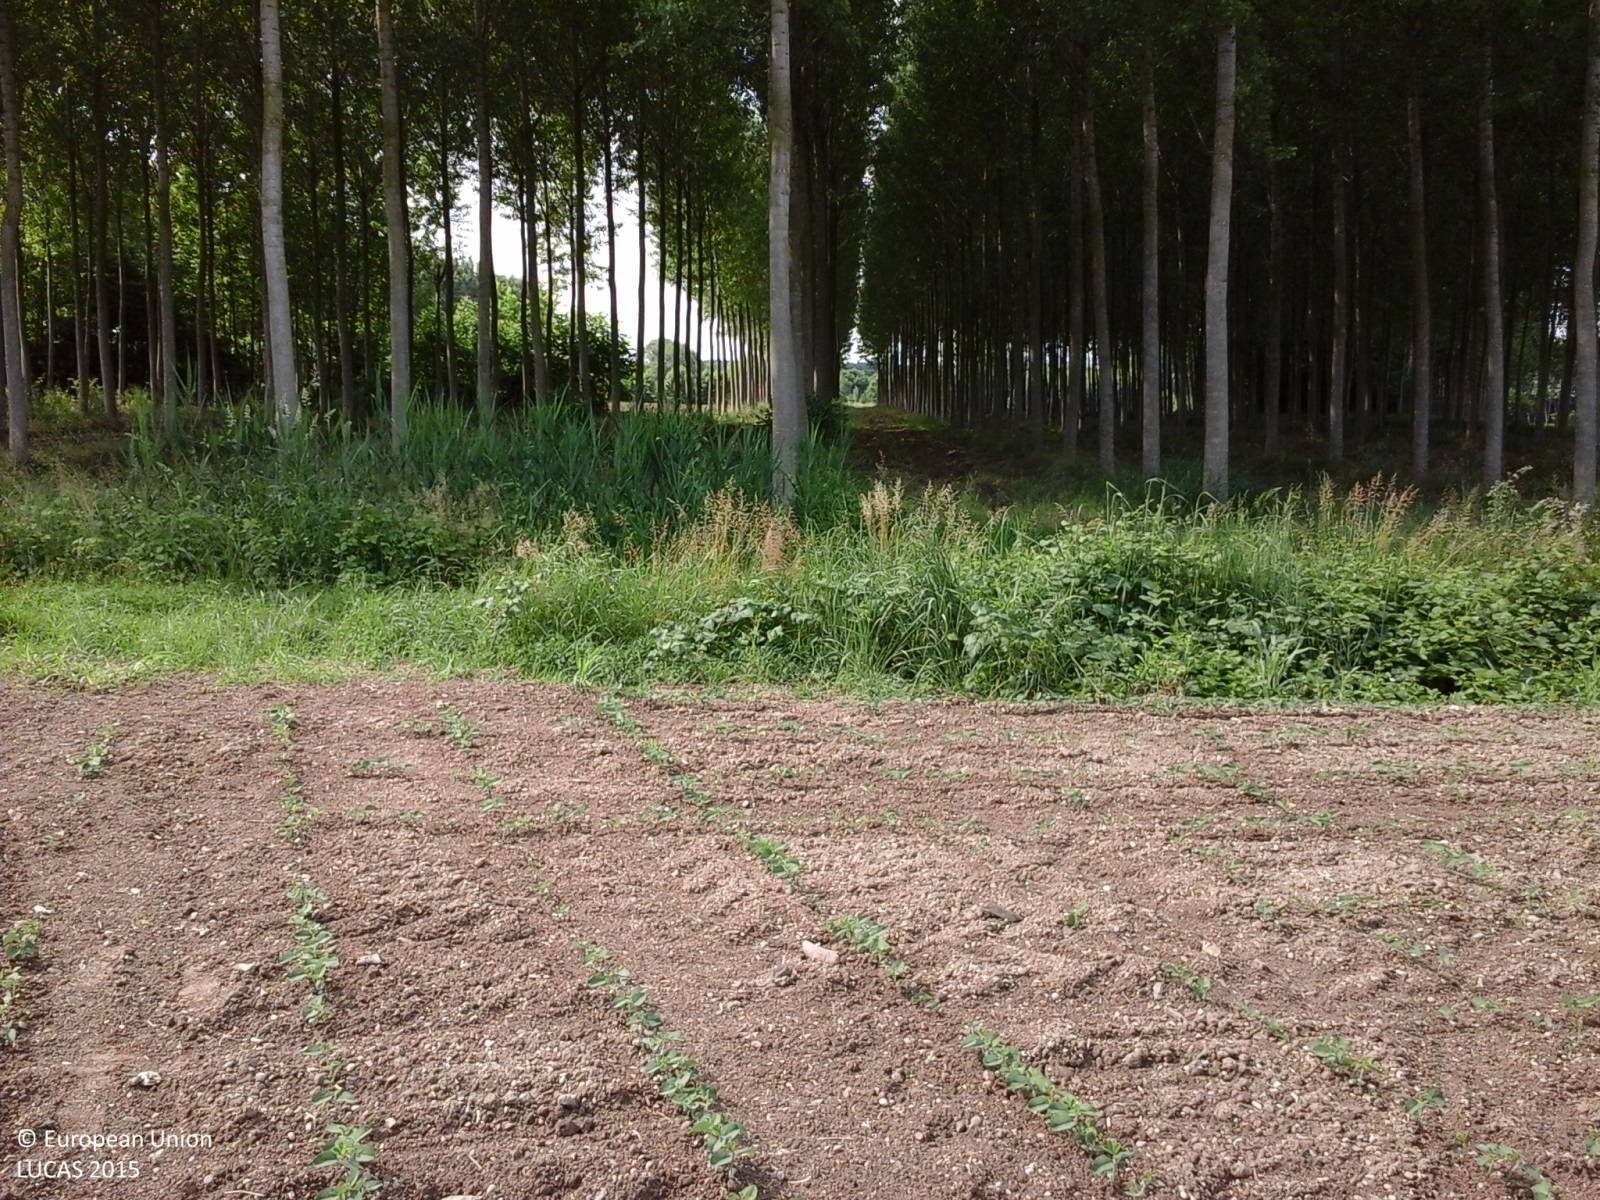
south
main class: Cropland
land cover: Soya
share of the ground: < 10 %
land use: Agriculture (excluding fallow land and kitchen gardens)
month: May
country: IT
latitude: 45.8526
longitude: 13.2028
